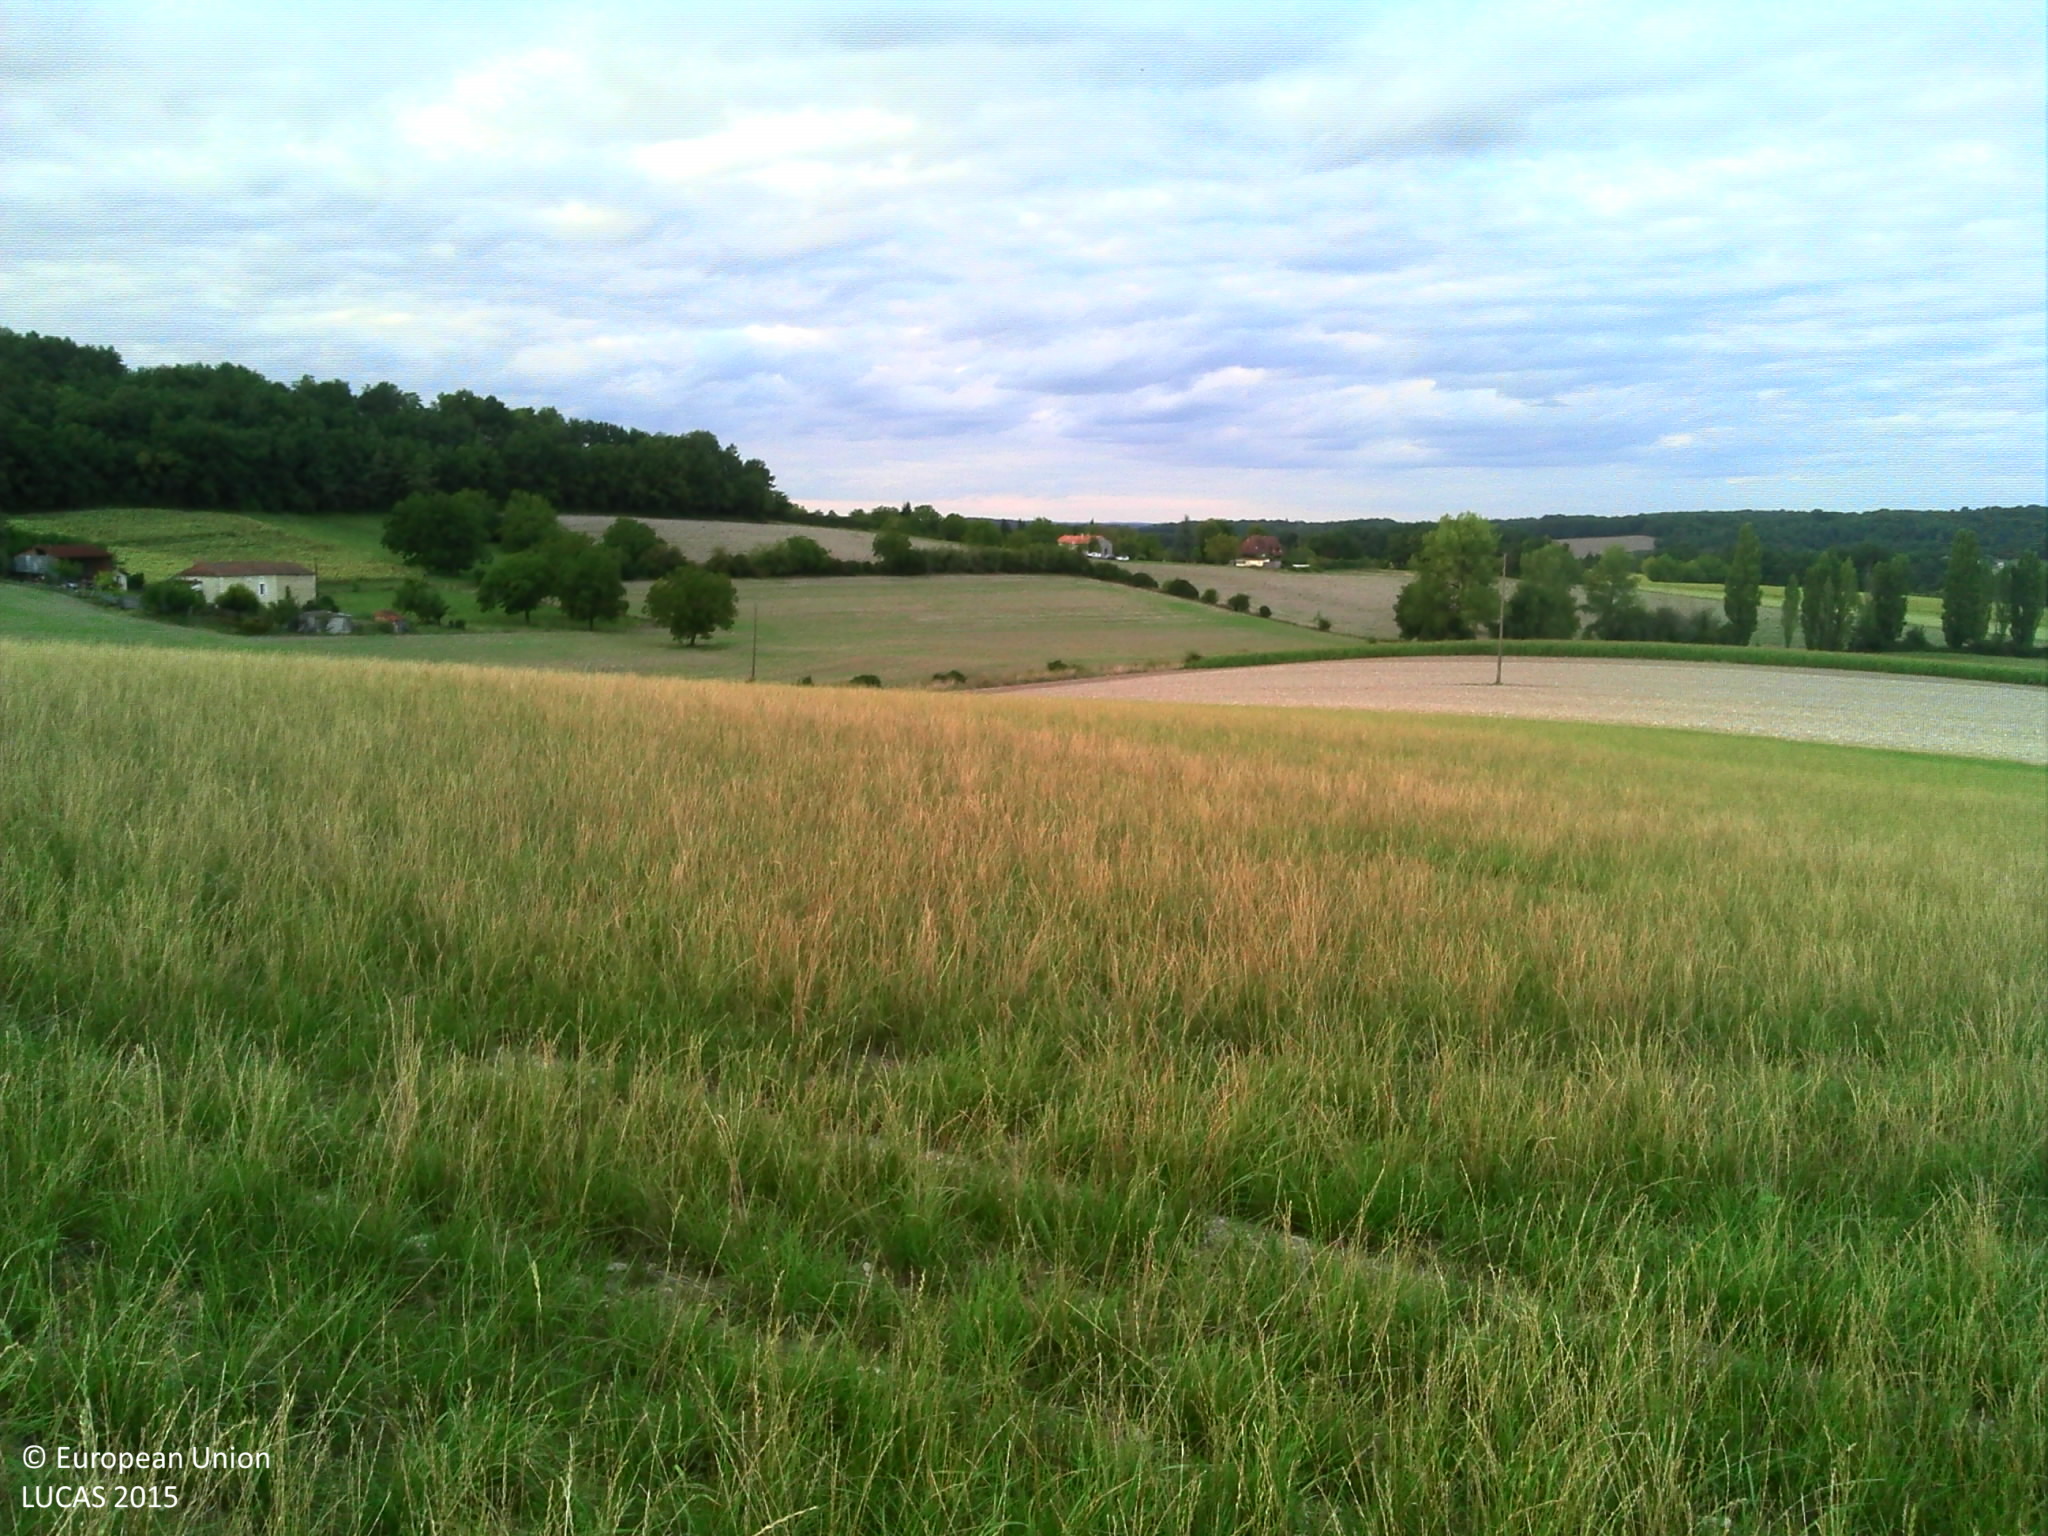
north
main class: Cropland
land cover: Temporary grasslands
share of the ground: > 75 %
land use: Agriculture (excluding fallow land and kitchen gardens)
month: August
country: FR
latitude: 45.2226
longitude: 0.5263
